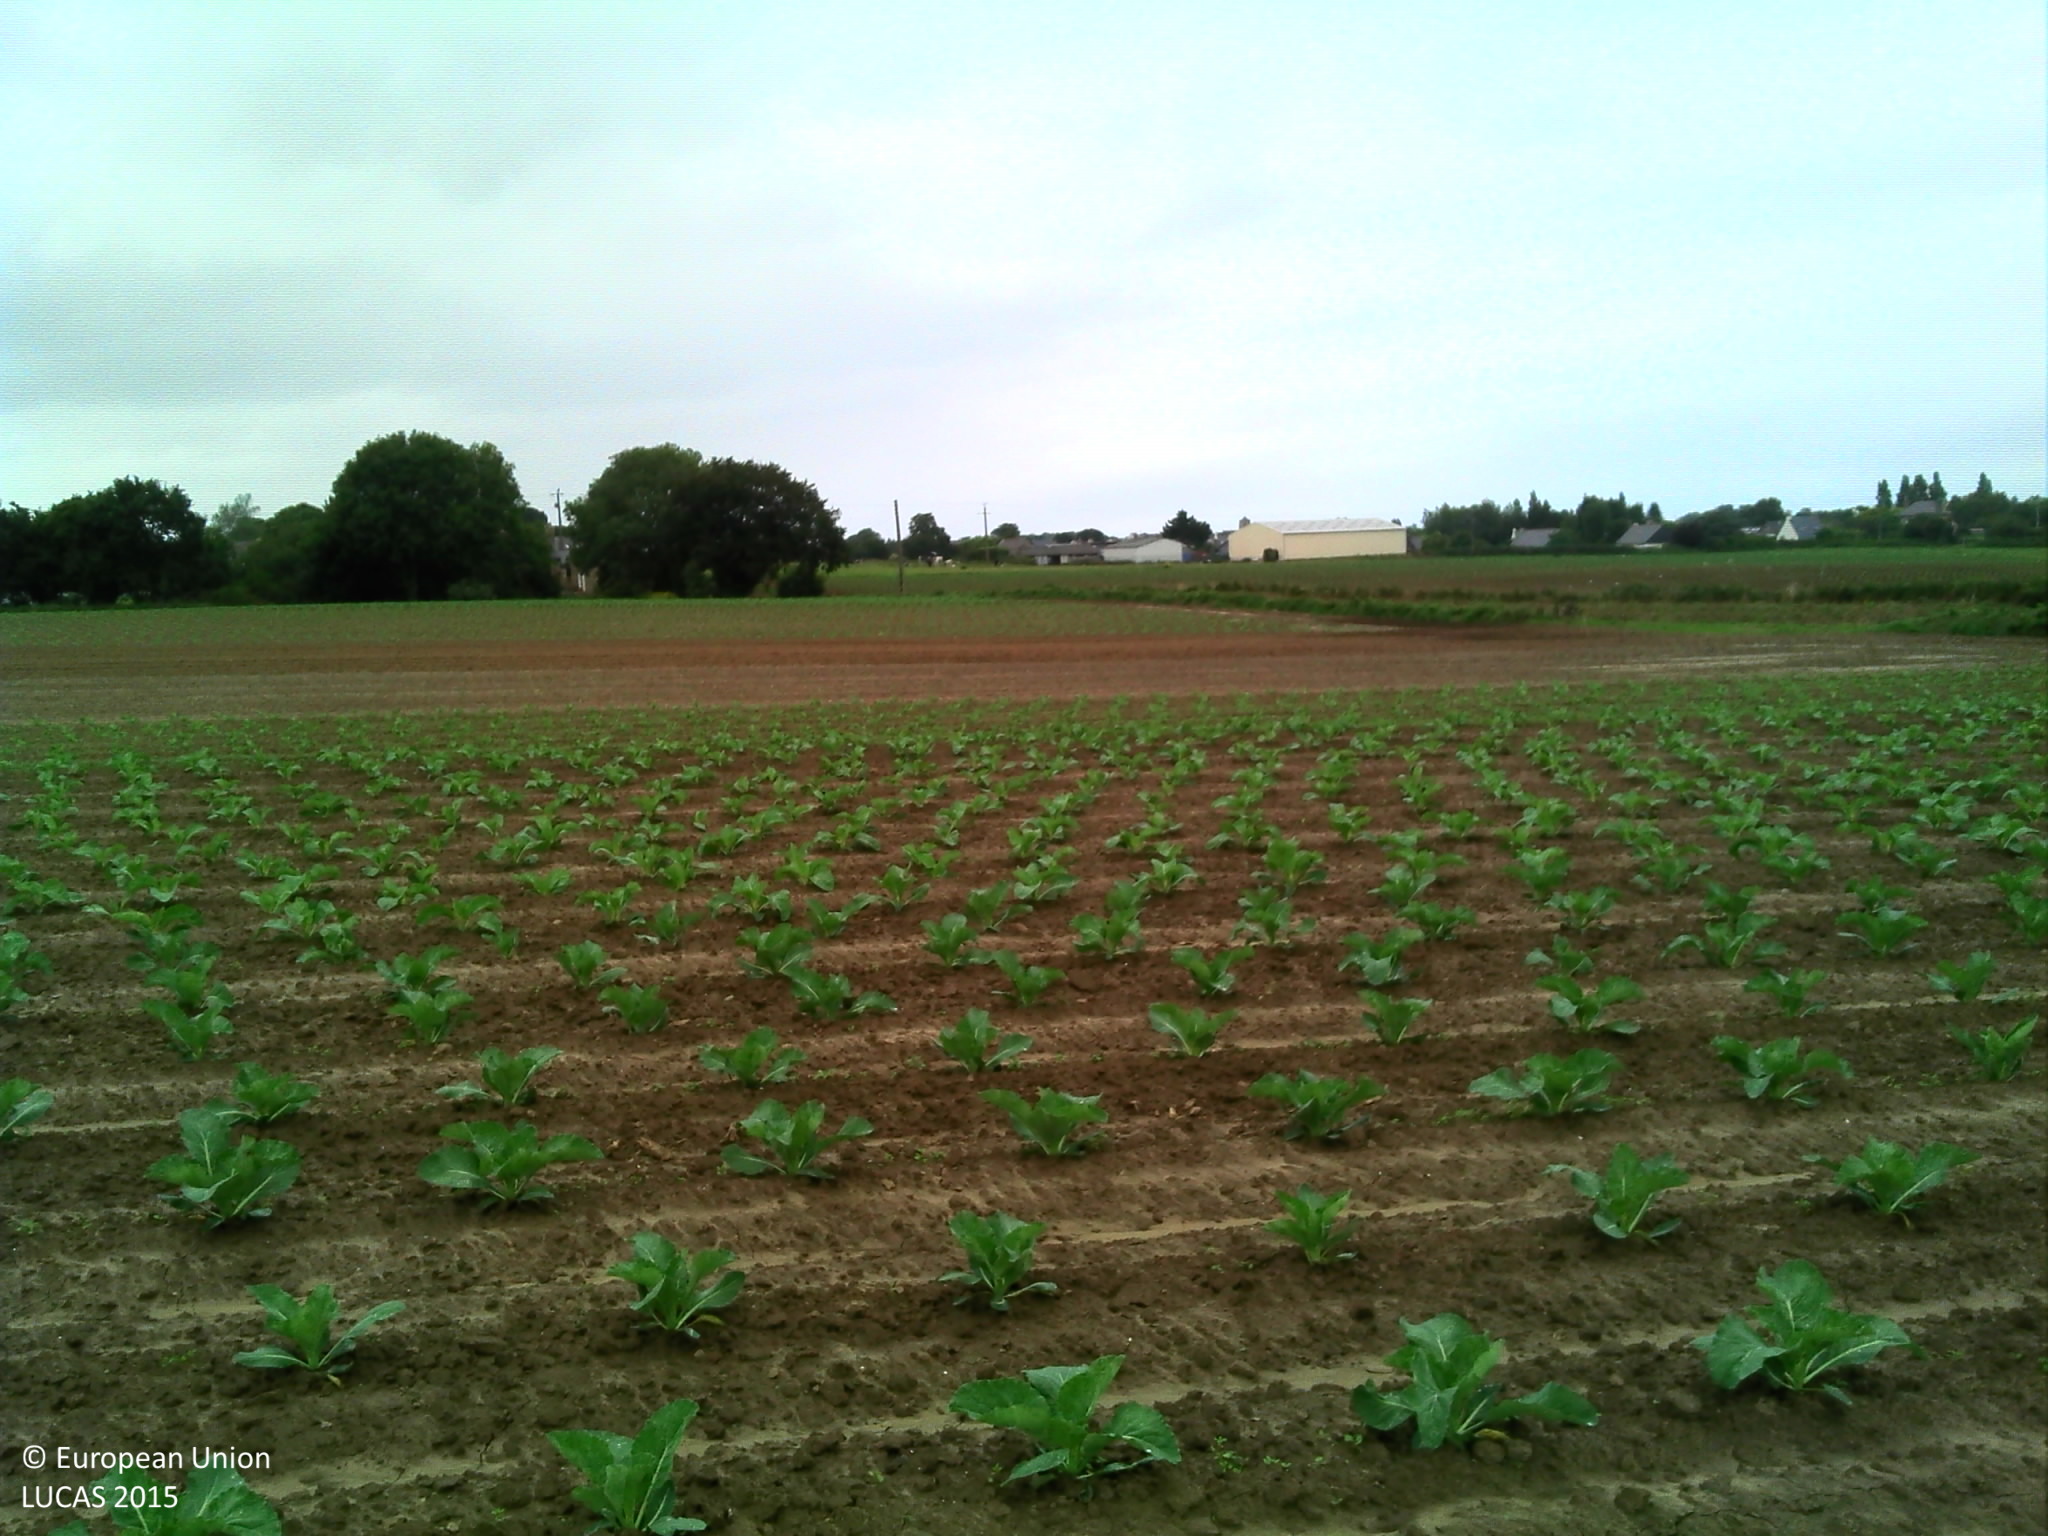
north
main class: Cropland
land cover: Other fresh vegetables
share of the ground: 10 - 25 %
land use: Agriculture (excluding fallow land and kitchen gardens)
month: August
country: FR
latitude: 48.7995
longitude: -3.2957
